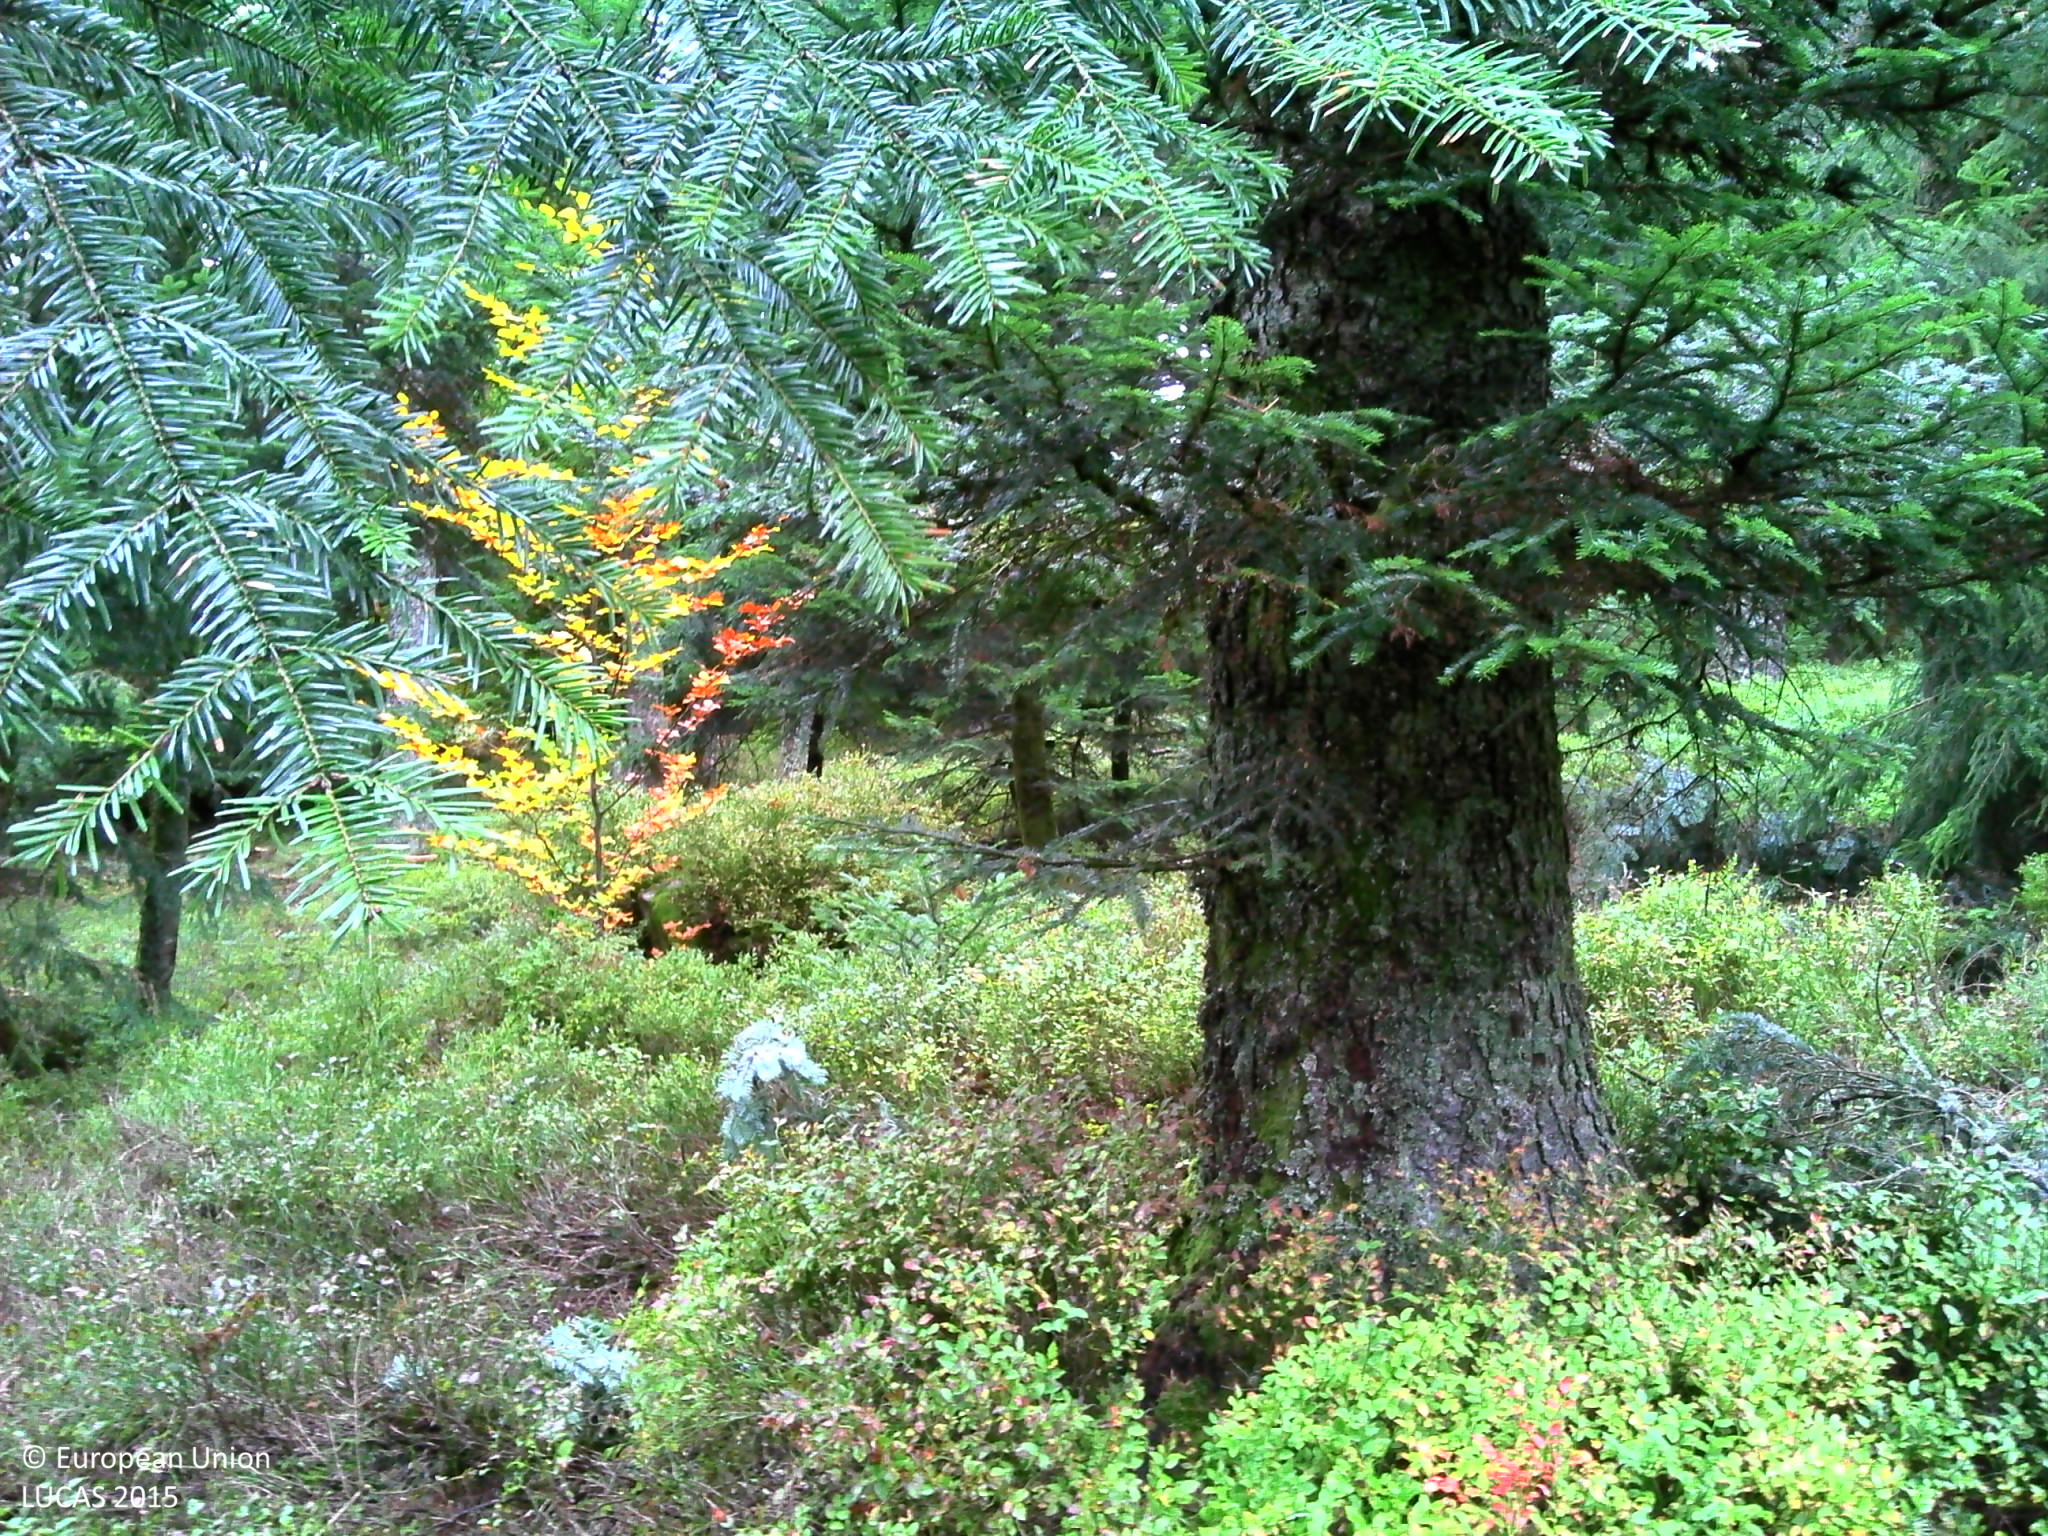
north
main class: Woodland
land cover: Other mixed woodland
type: alpine coniferous forest
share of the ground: 50 - 75 %
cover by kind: coniferous forest trees 45 %, shrubs 25 %, broadleaved forest trees 15 %, lichens and mosses 10 %, herbaceous plants 5 %
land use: Forestry
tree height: > 5 m
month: October
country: FR
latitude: 45.9467
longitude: 3.6670
